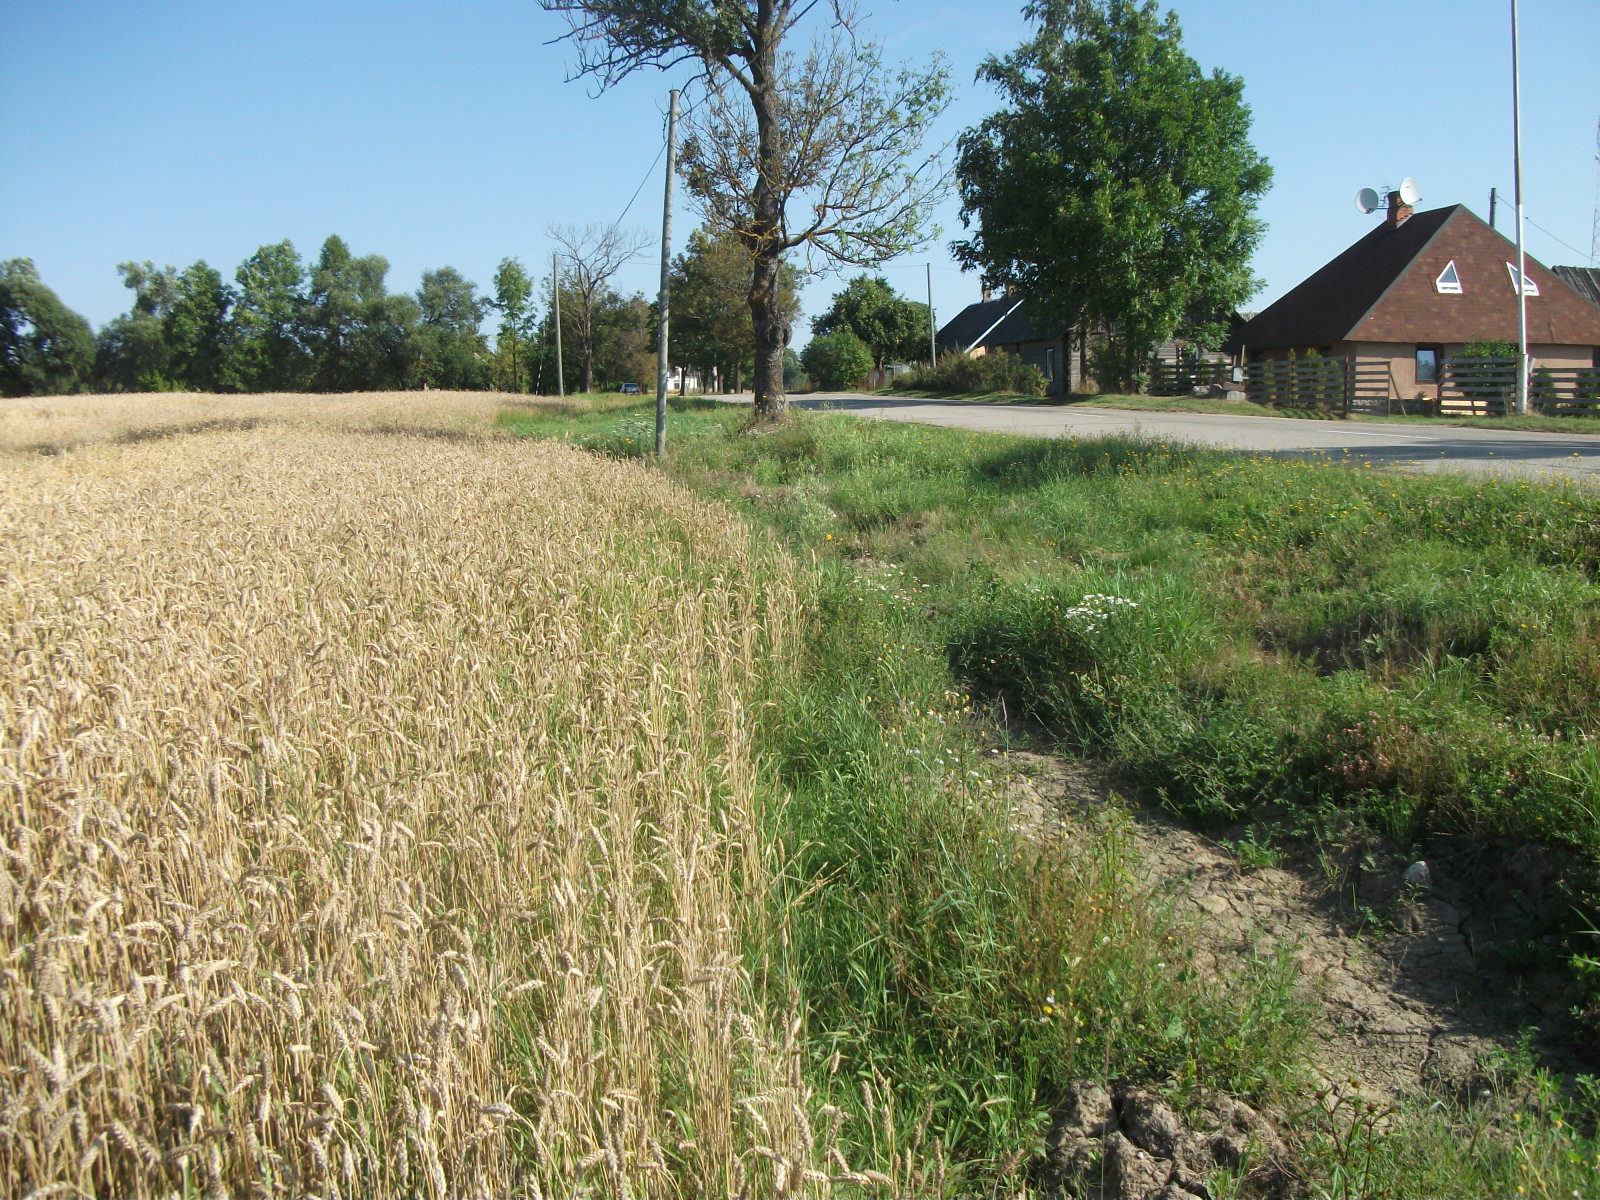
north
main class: Cropland
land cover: Common wheat
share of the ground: > 75 %
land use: Agriculture (excluding fallow land and kitchen gardens)
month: August
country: LV
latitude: 56.7323
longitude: 26.6098
